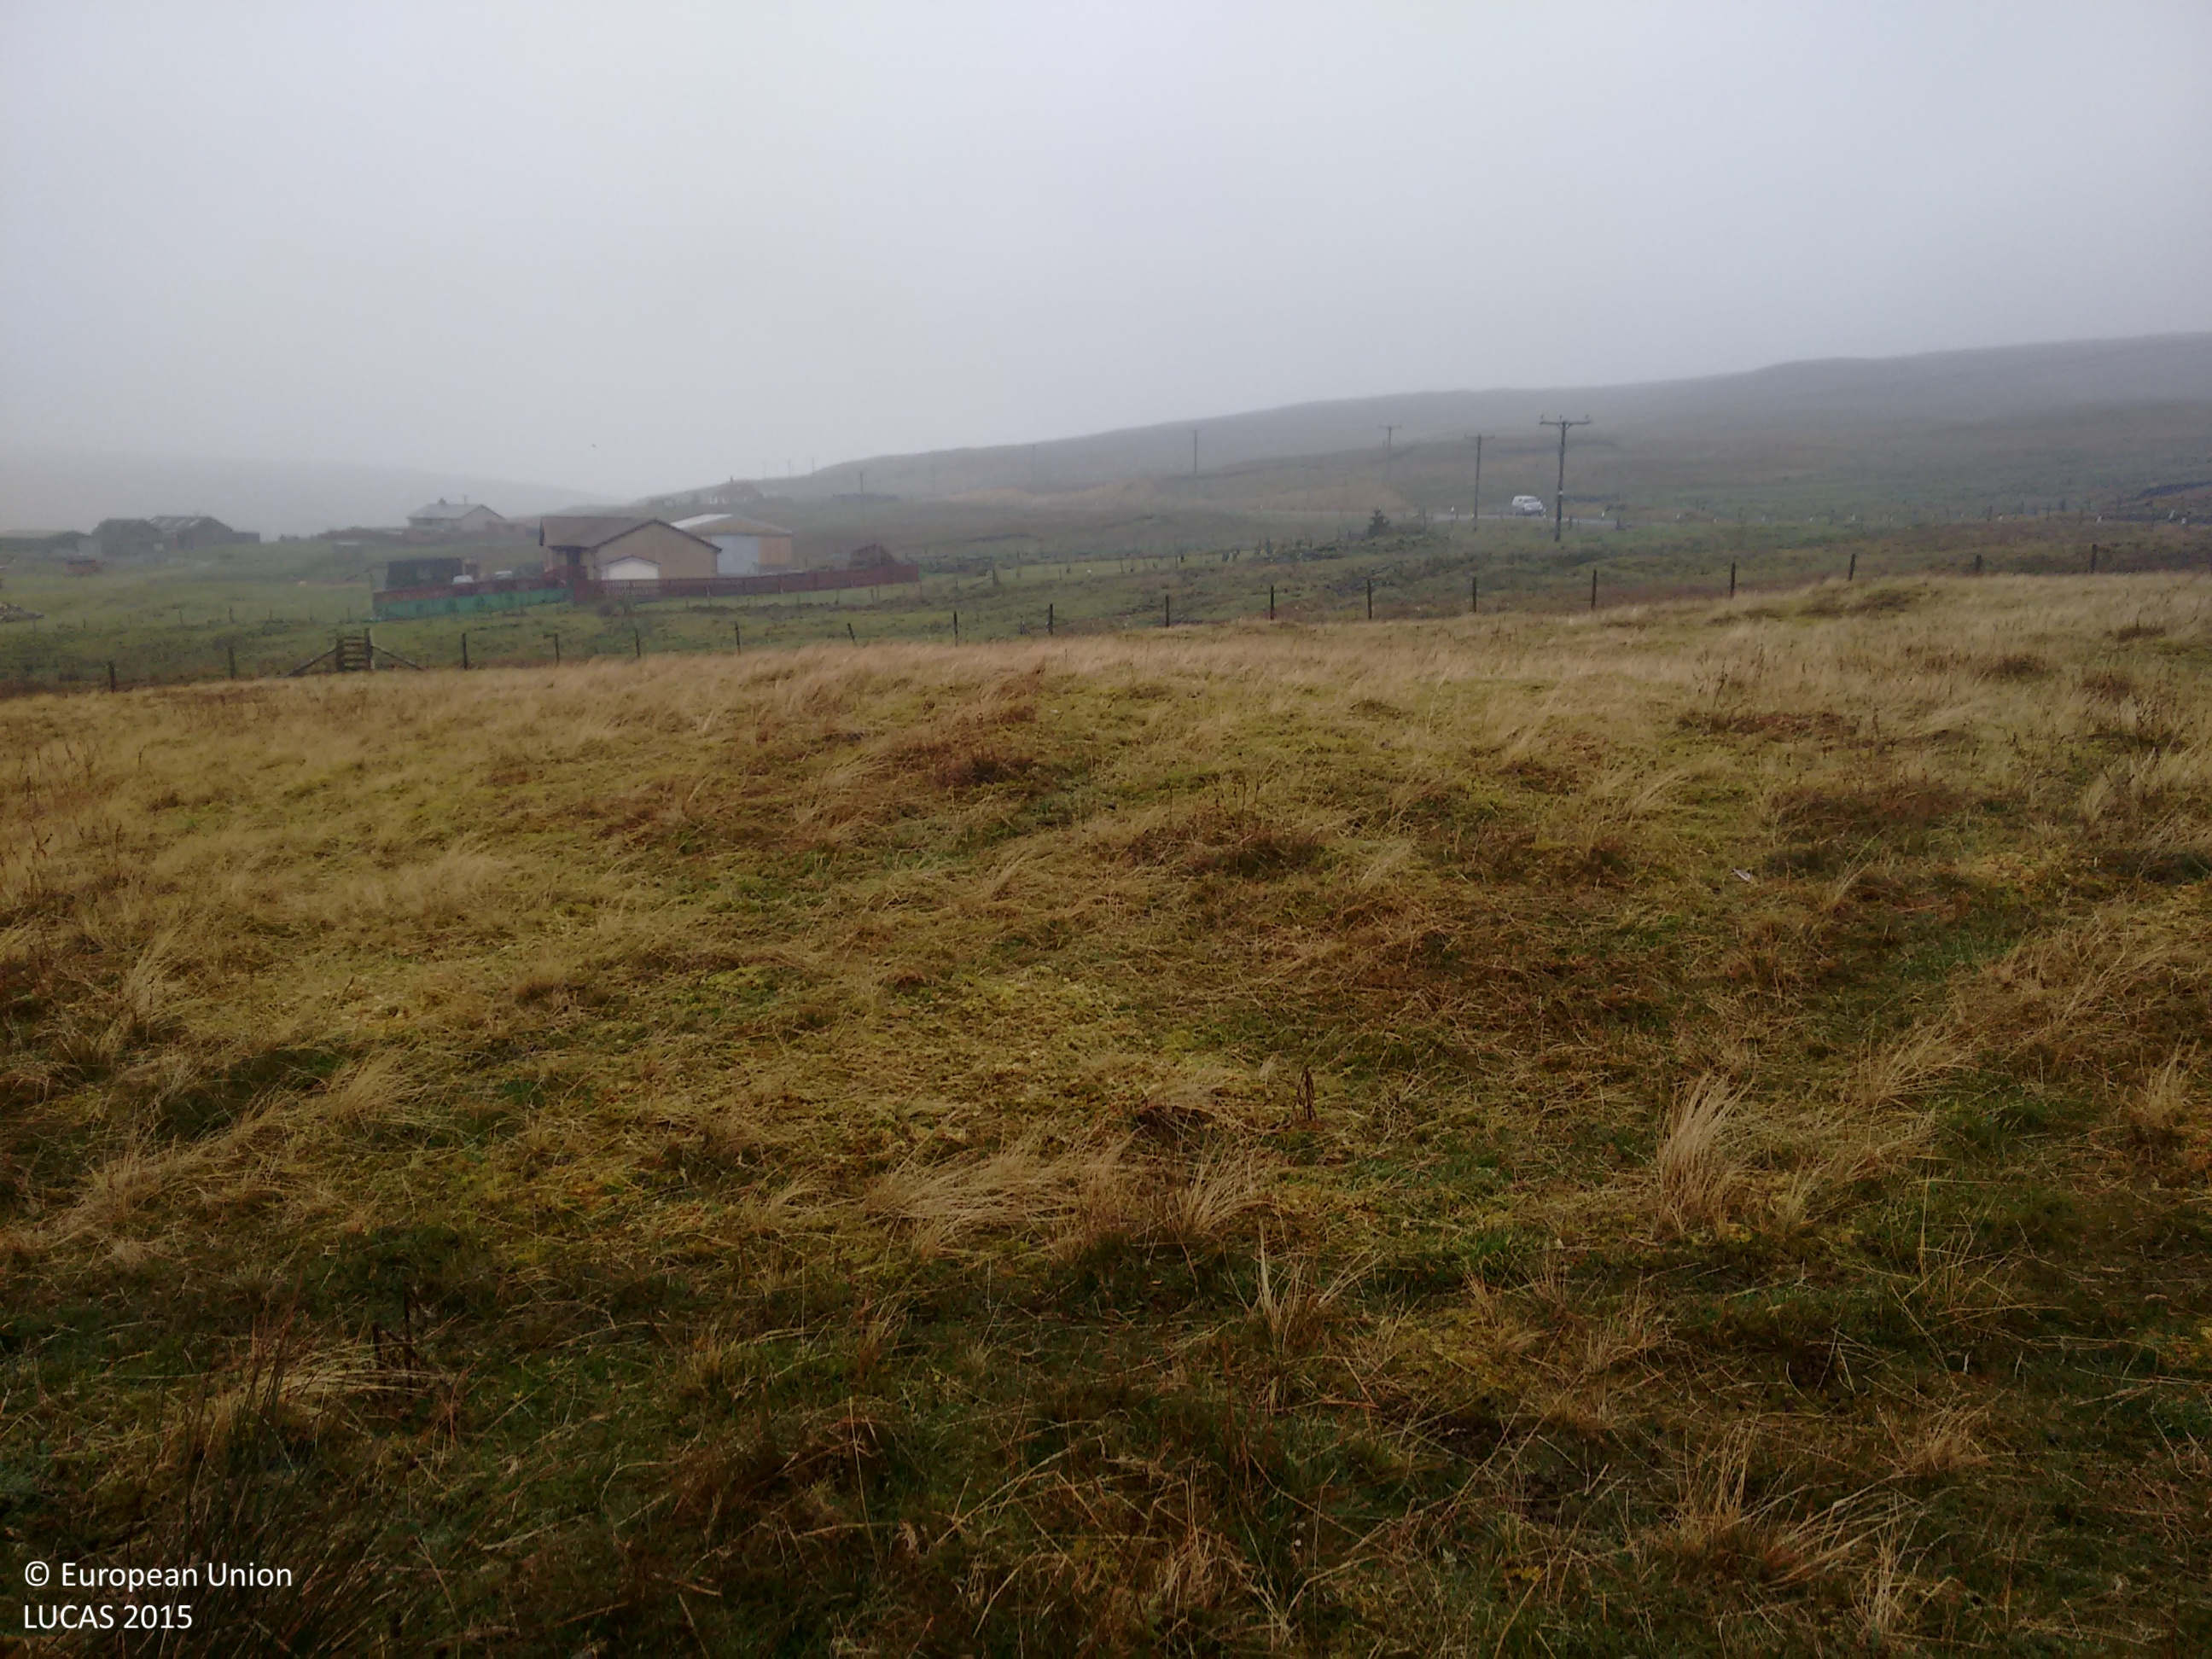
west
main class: Grassland
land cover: Grassland without tree/shrub cover
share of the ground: > 75 %
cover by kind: herbaceous plants 100 %
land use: Agriculture (excluding fallow land and kitchen gardens)
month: November
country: GB
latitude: 60.3551
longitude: -1.1641
